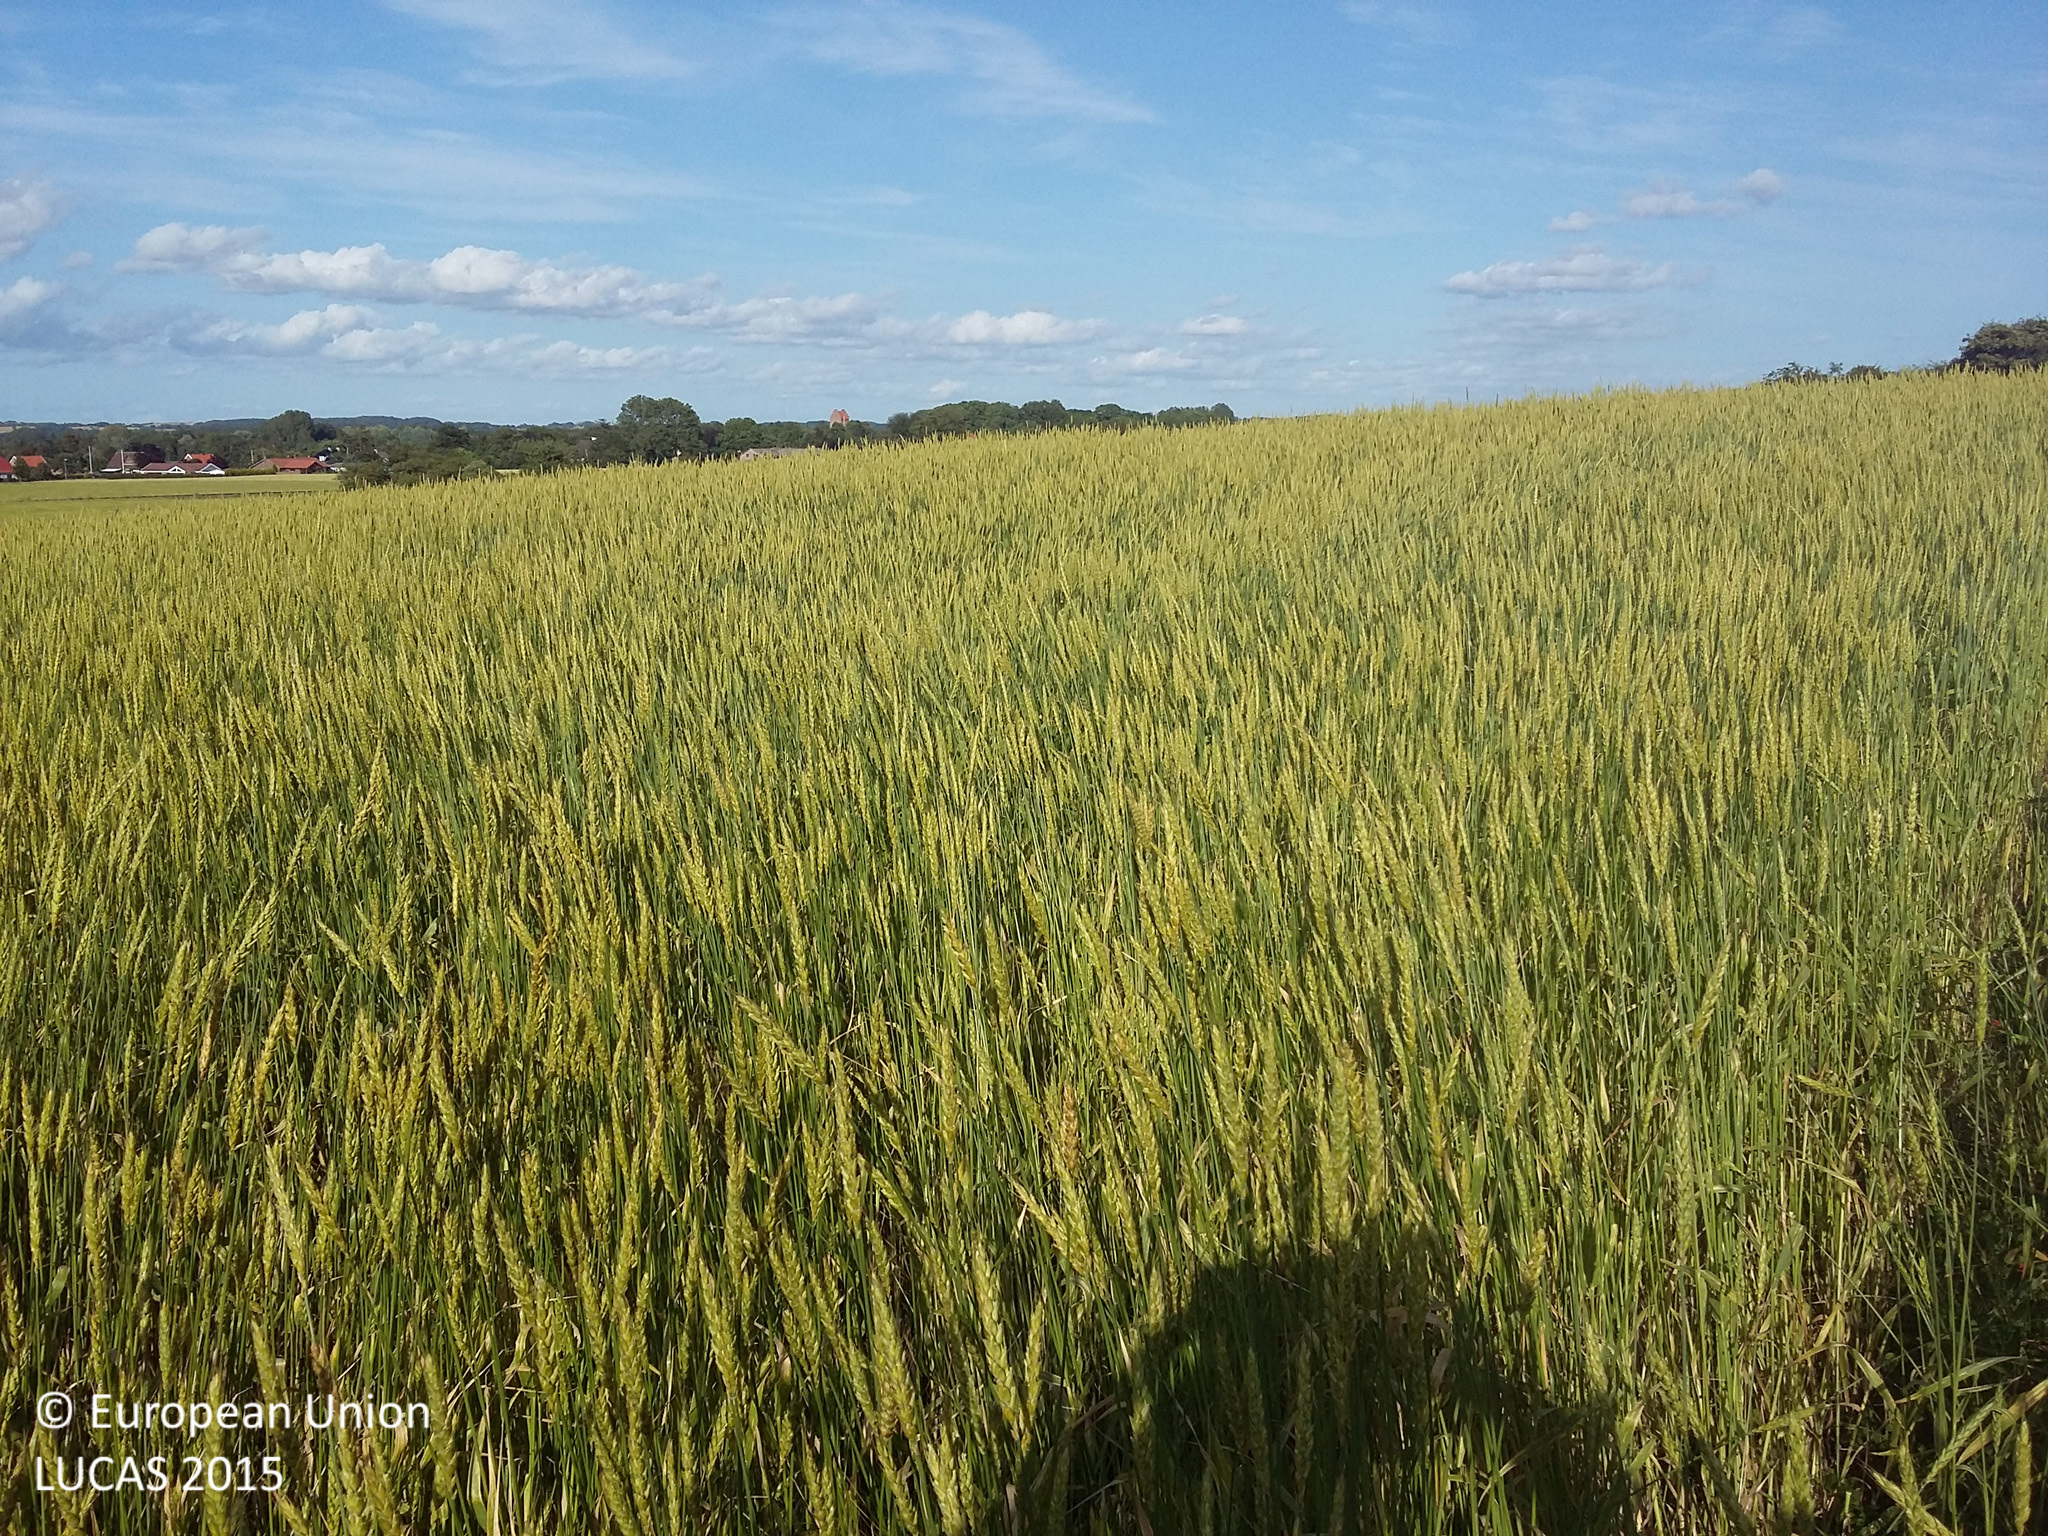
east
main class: Cropland
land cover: Common wheat
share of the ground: > 75 %
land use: Agriculture (excluding fallow land and kitchen gardens)
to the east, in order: Common wheat; Broadleaved woodland; Rape and turnip rape
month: July
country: DK
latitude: 55.6603
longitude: 11.2545
